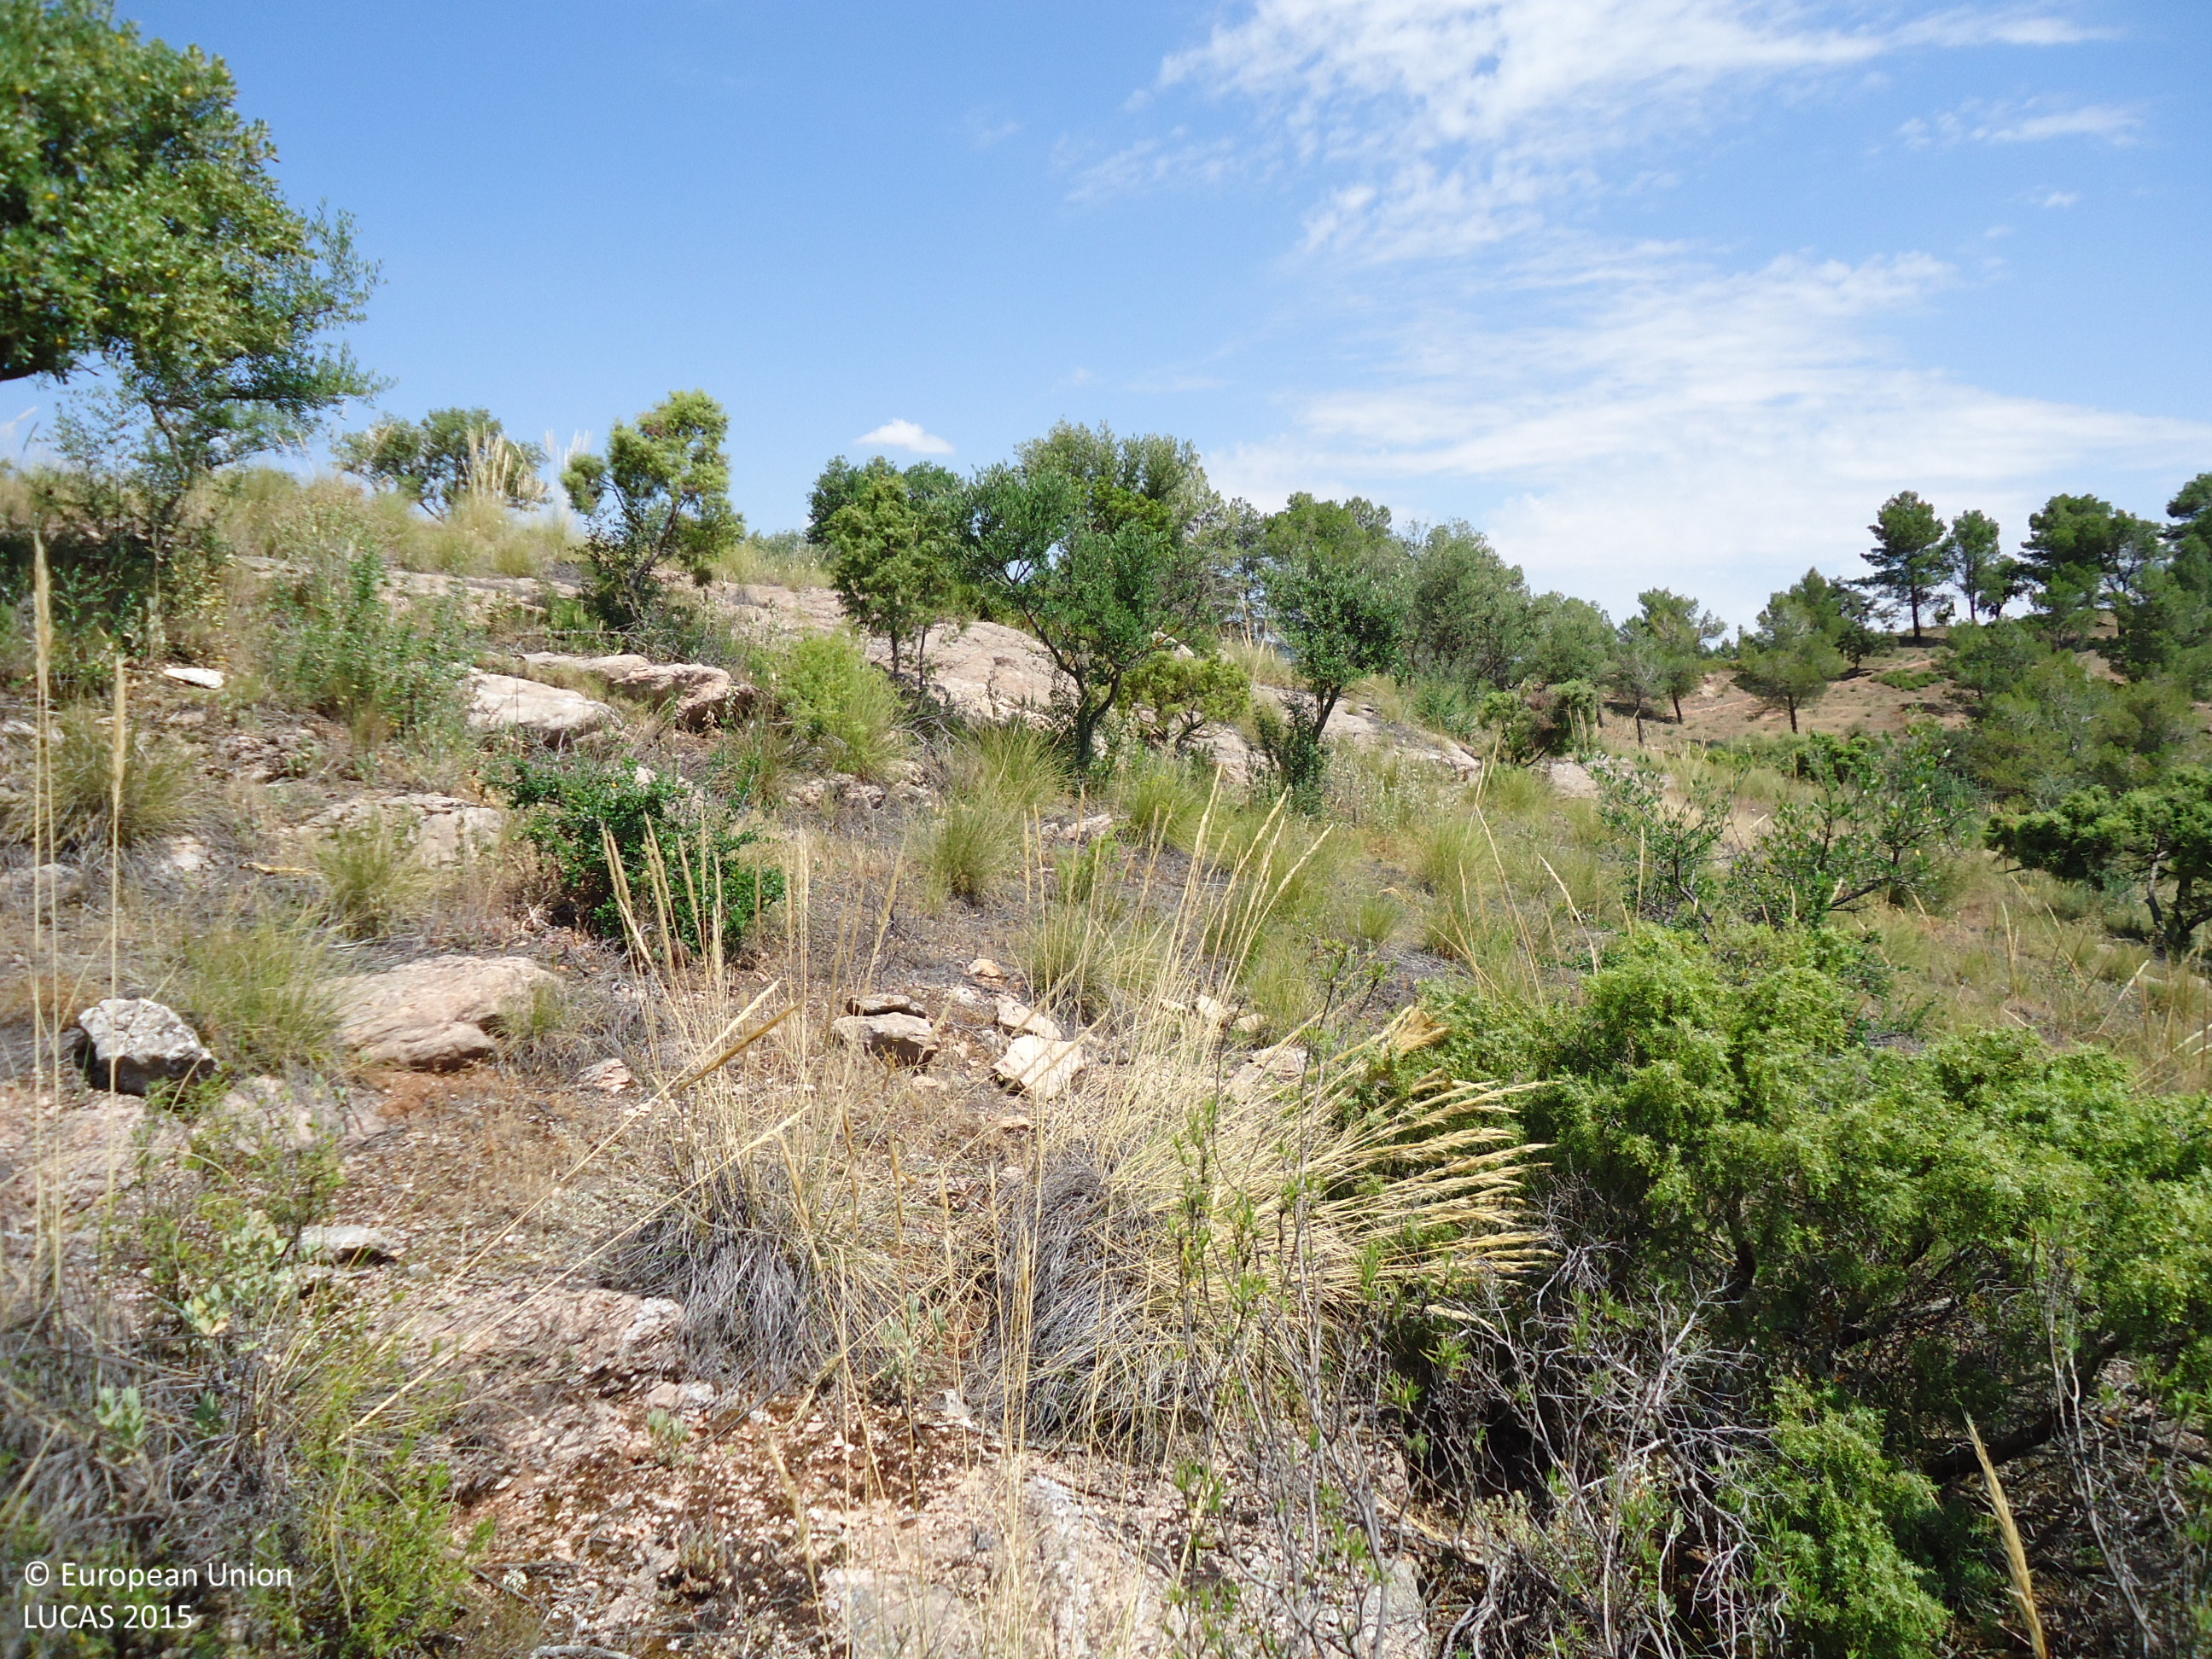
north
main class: Shrubland
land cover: Shrubland with sparse tree cover
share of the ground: > 75 %
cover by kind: shrubs 90 %, broadleaved forest trees 5 %, consolidated bare surface 5 %
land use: Semi-natural and natural areas not in use
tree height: < 5 m
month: June
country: ES
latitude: 36.7786
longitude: -4.9553
